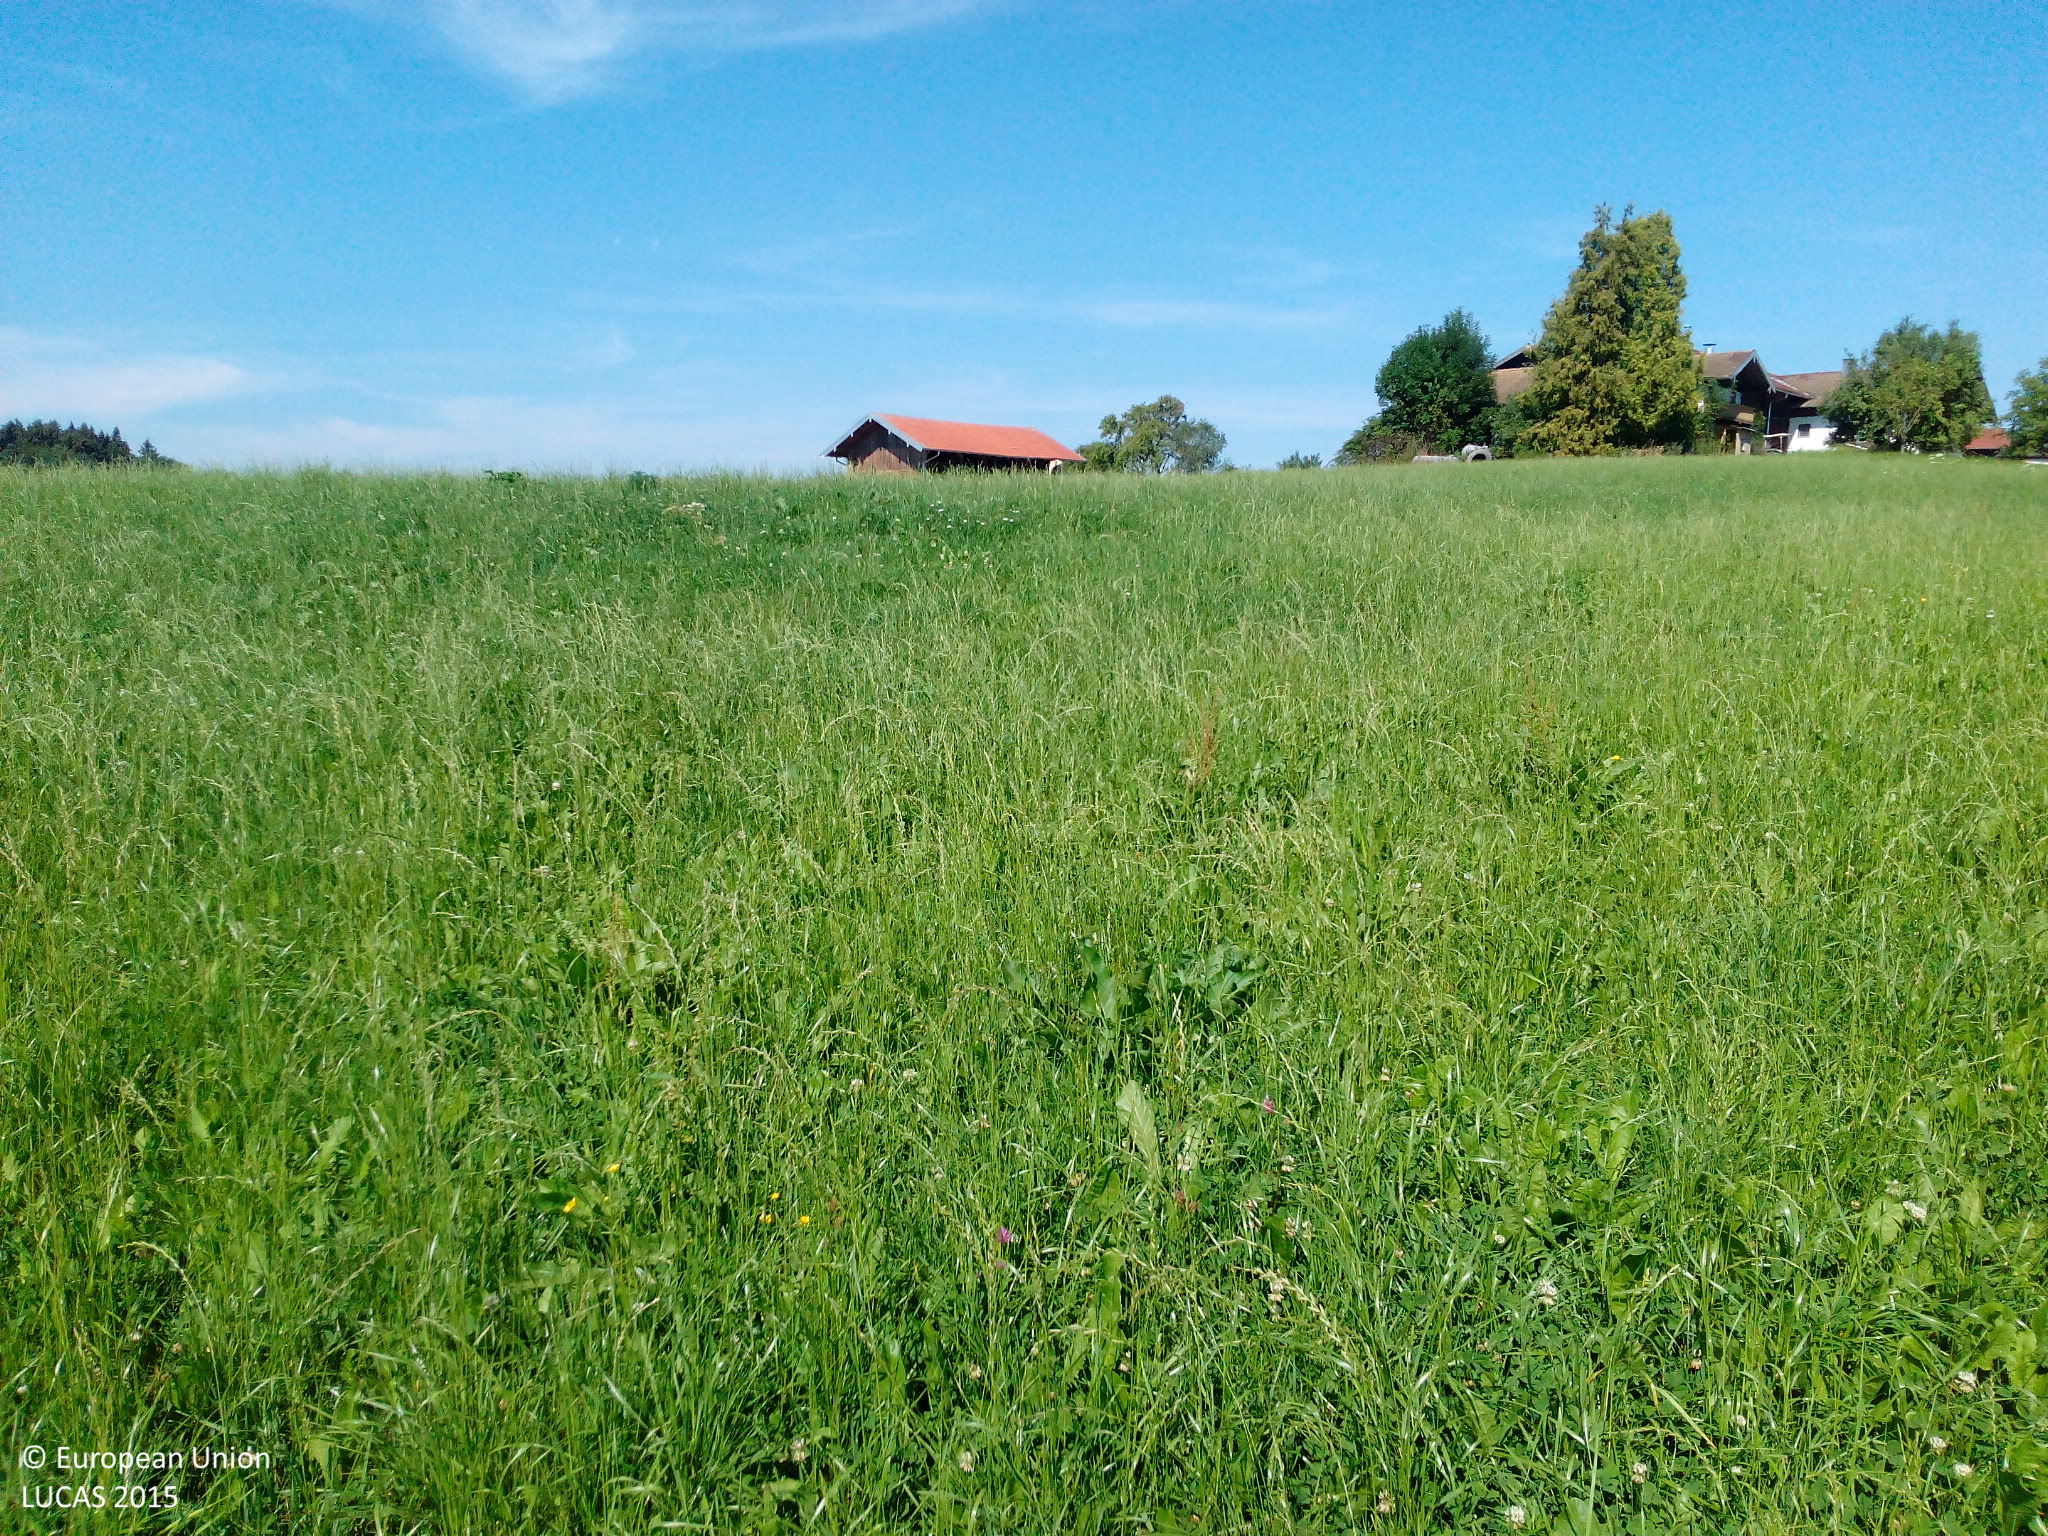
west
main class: Grassland
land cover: Grassland without tree/shrub cover
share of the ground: > 75 %
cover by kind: herbaceous plants 100 %
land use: Agriculture (excluding fallow land and kitchen gardens)
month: August
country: DE
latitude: 47.9000
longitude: 12.7944
